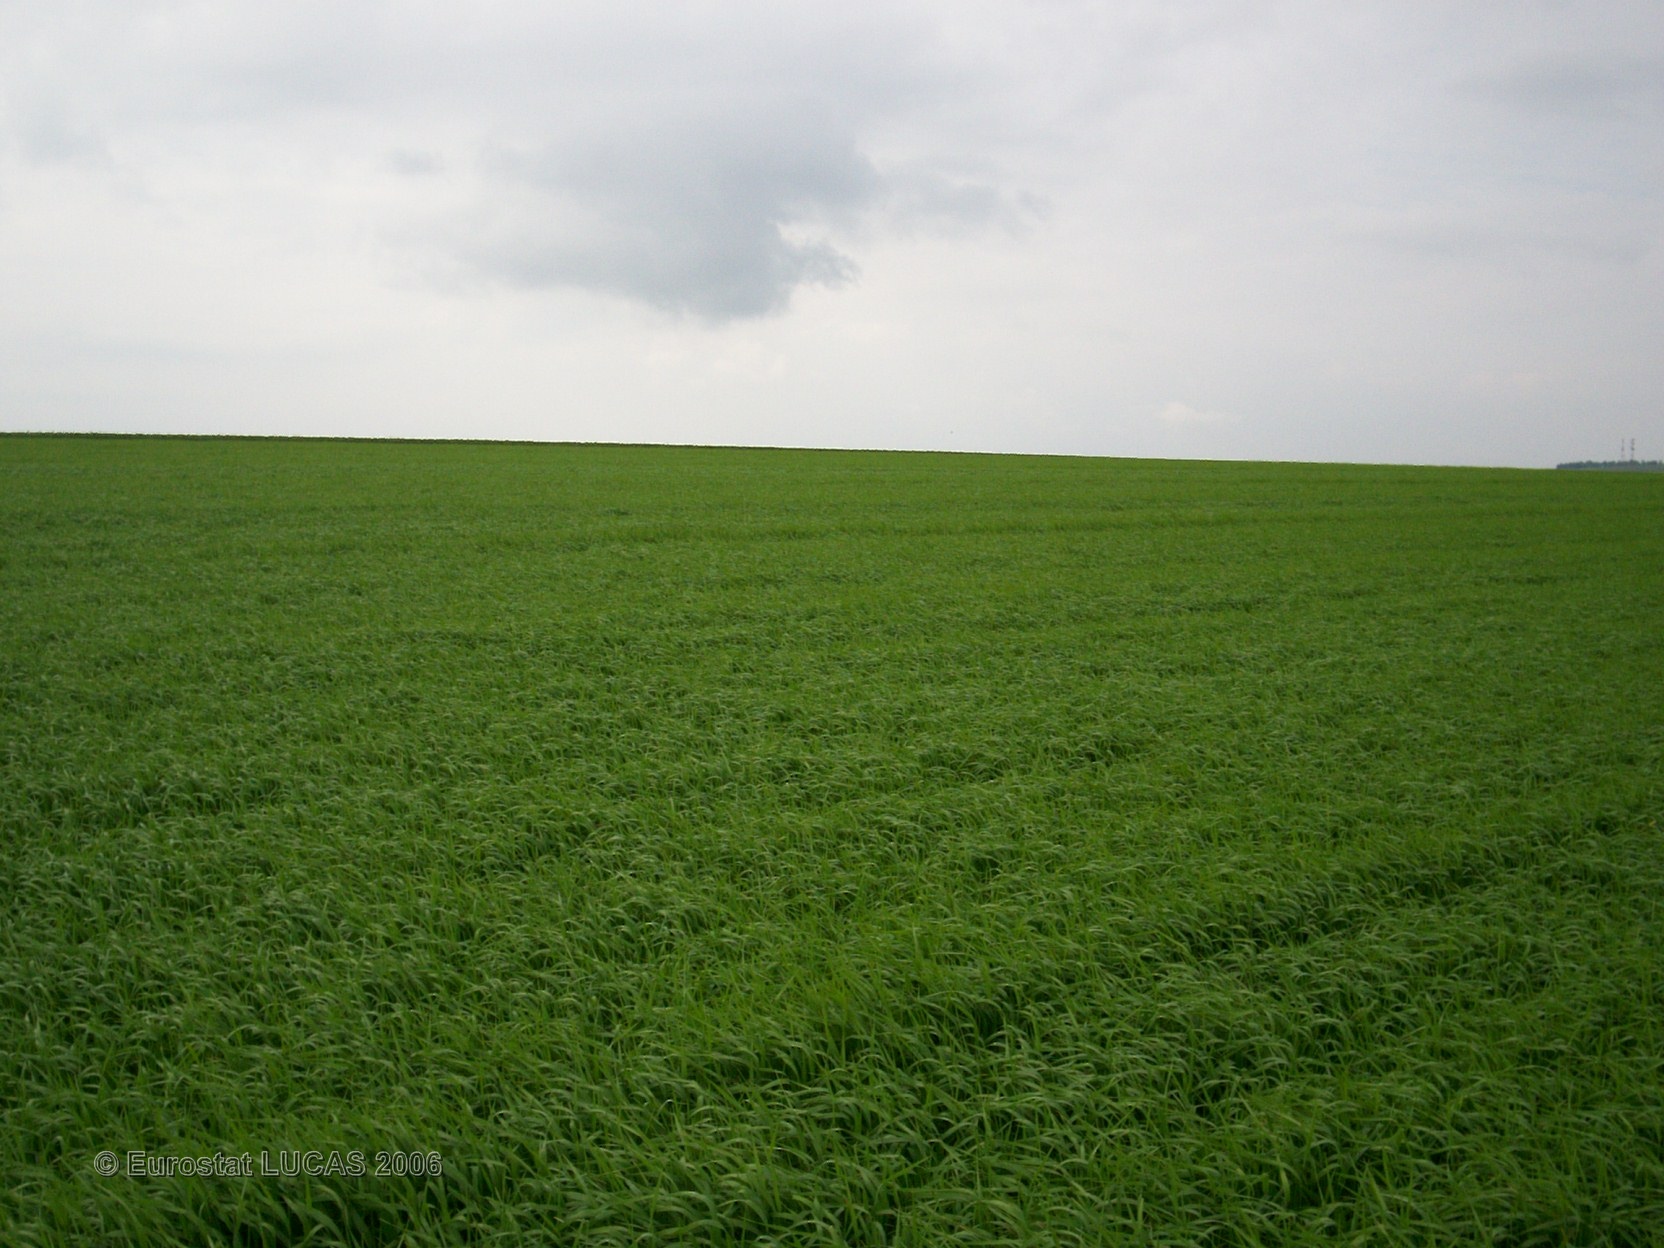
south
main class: Cropland
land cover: Barley
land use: Agriculture (excluding fallow land and kitchen gardens)
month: June
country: FR
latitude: 48.7309
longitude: 4.4089
